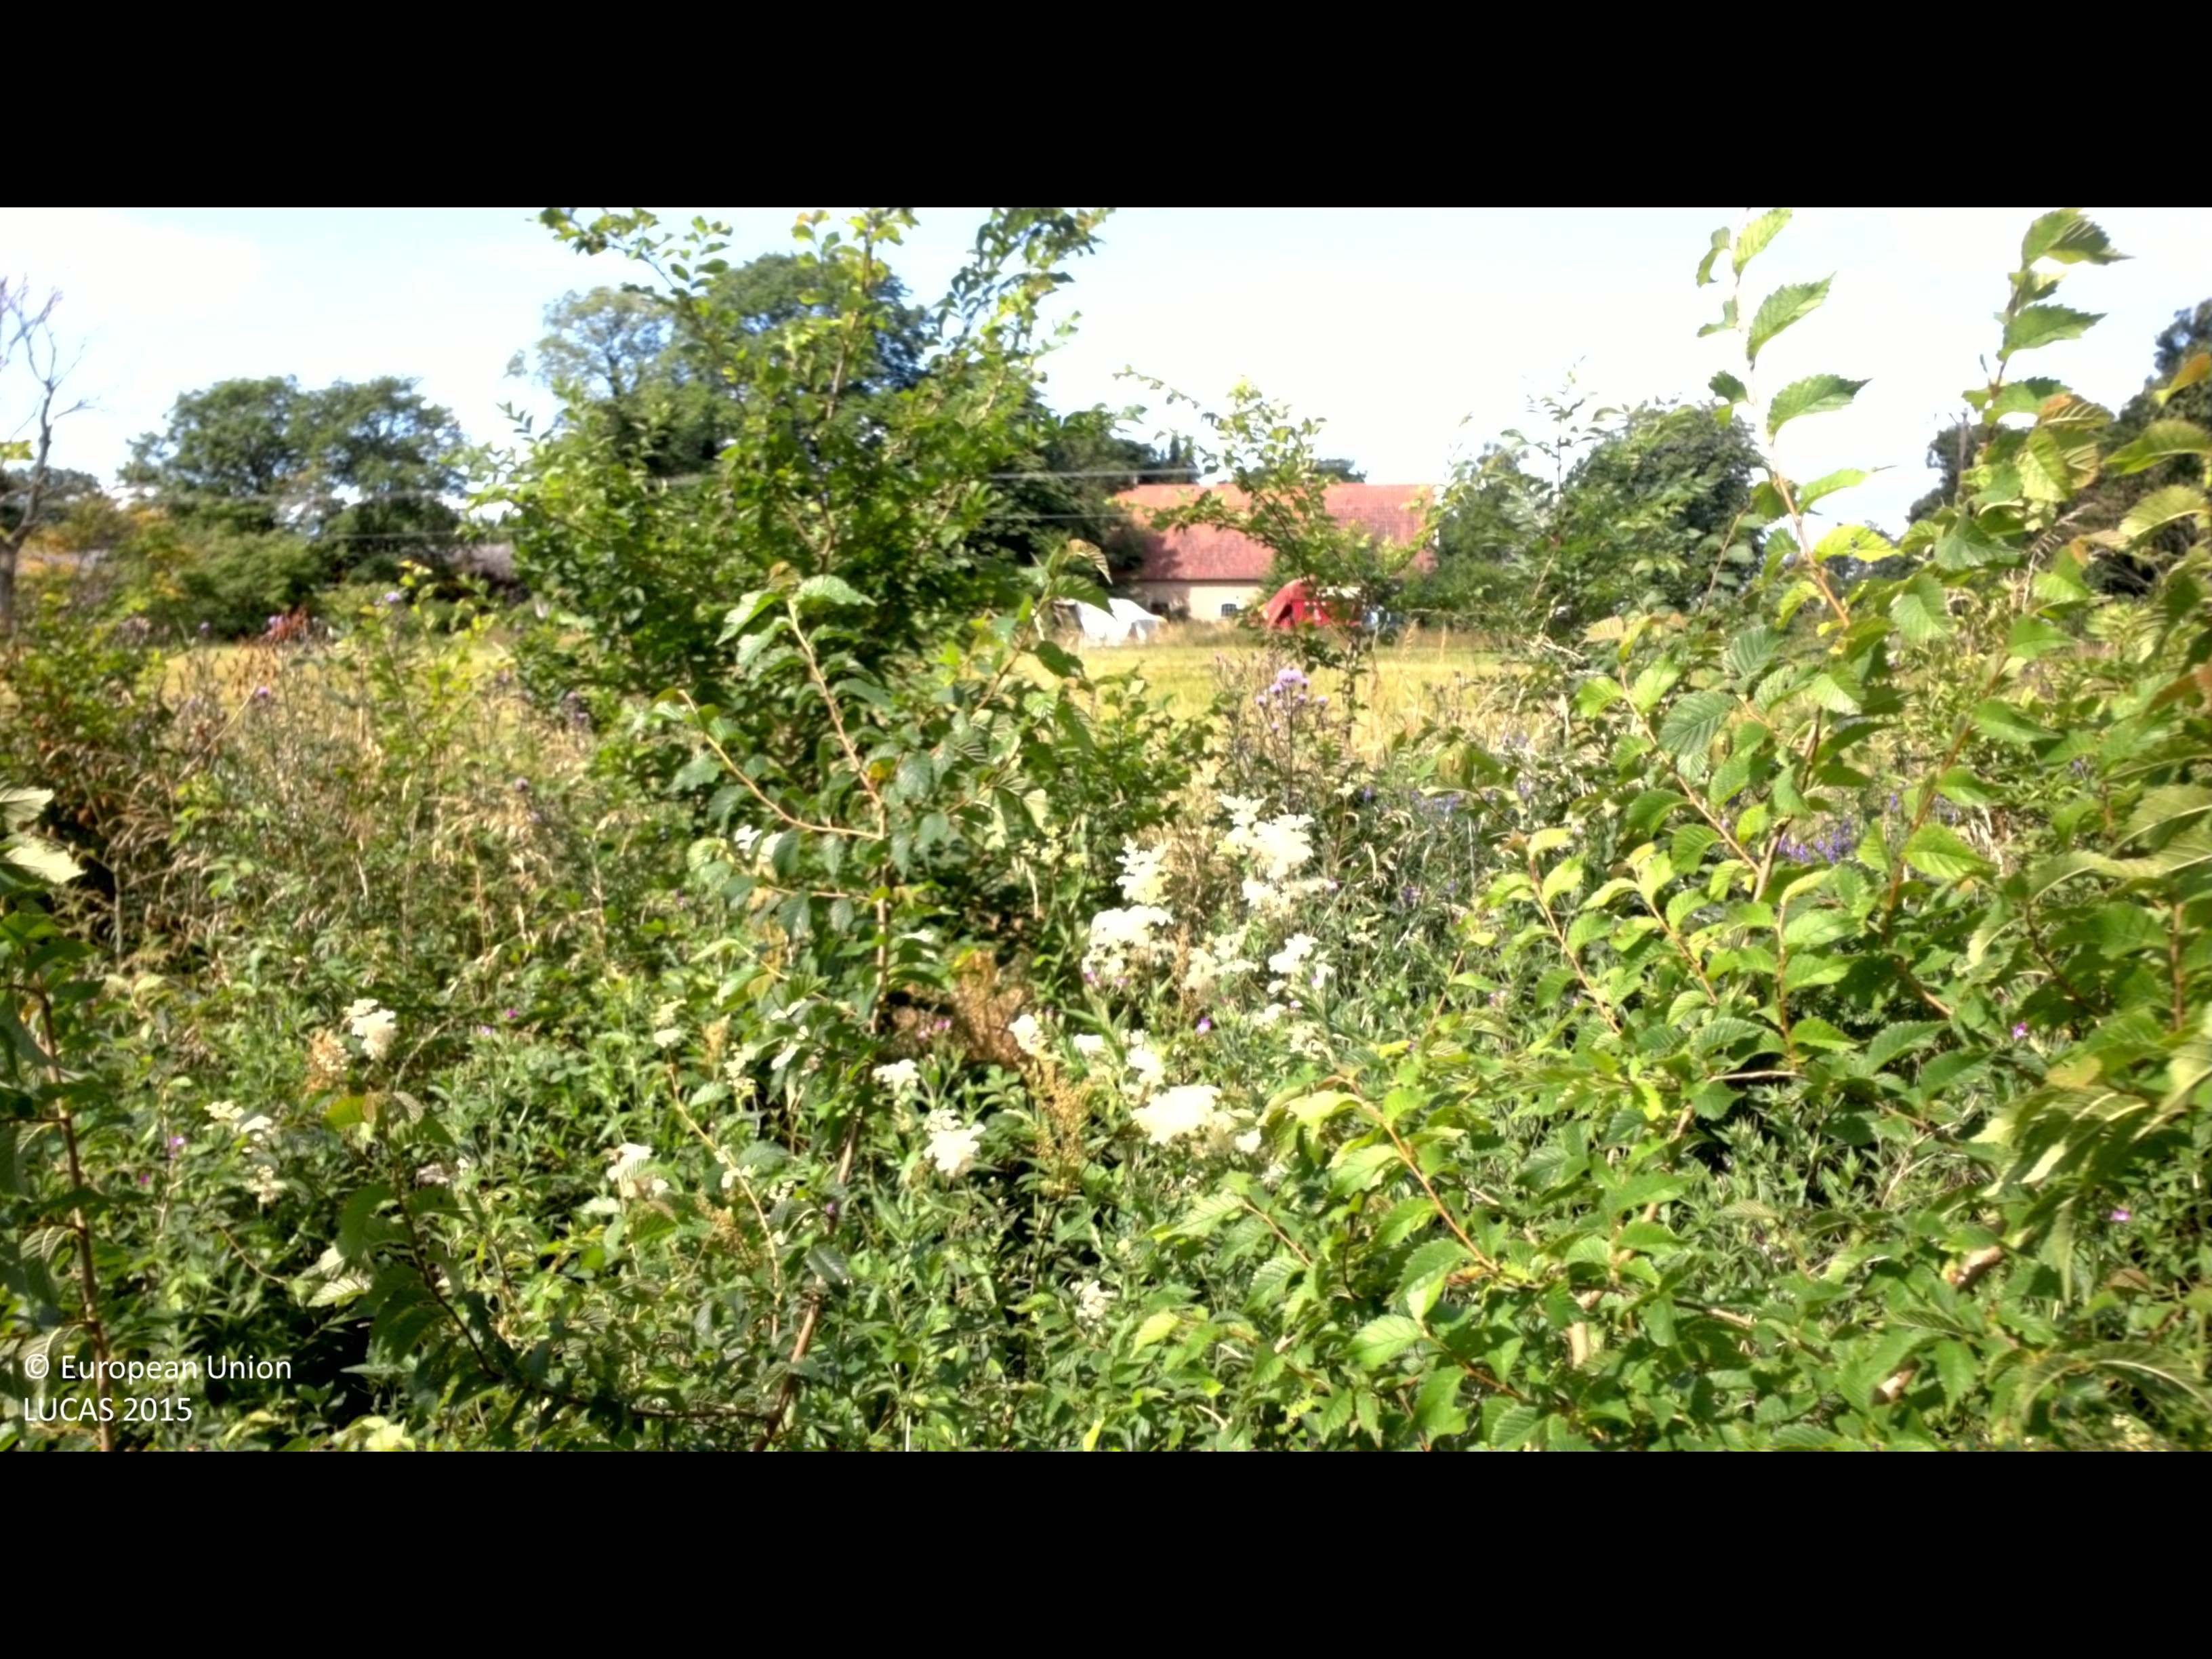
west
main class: Woodland
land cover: Broadleaved woodland
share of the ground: > 75 %
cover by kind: broadleaved forest trees 75 %, shrubs 20 %, herbaceous plants 5 %
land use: Semi-natural and natural areas not in use
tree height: > 5 m
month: July
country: SE
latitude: 56.4768
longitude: 16.4471
